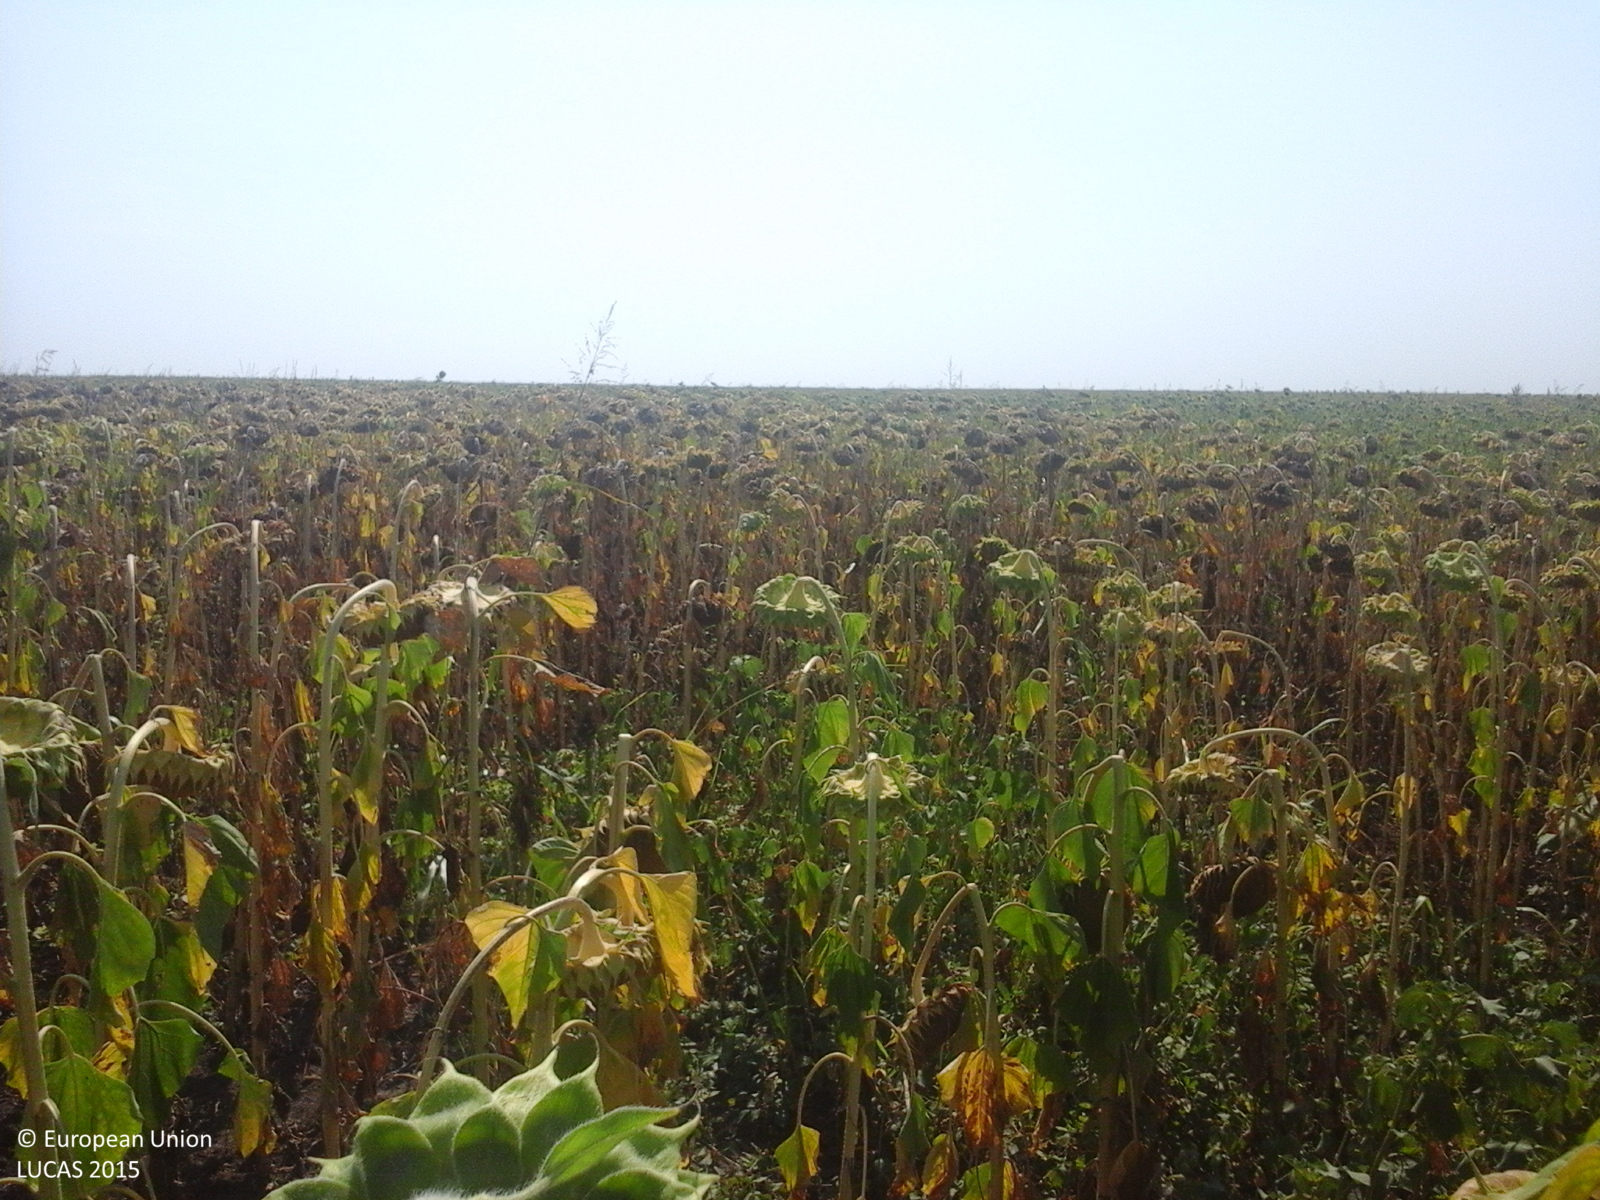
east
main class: Cropland
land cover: Sunflower
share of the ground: > 75 %
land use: Agriculture (excluding fallow land and kitchen gardens)
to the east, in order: Sunflower
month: August
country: RO
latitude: 45.7251
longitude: 27.5946
